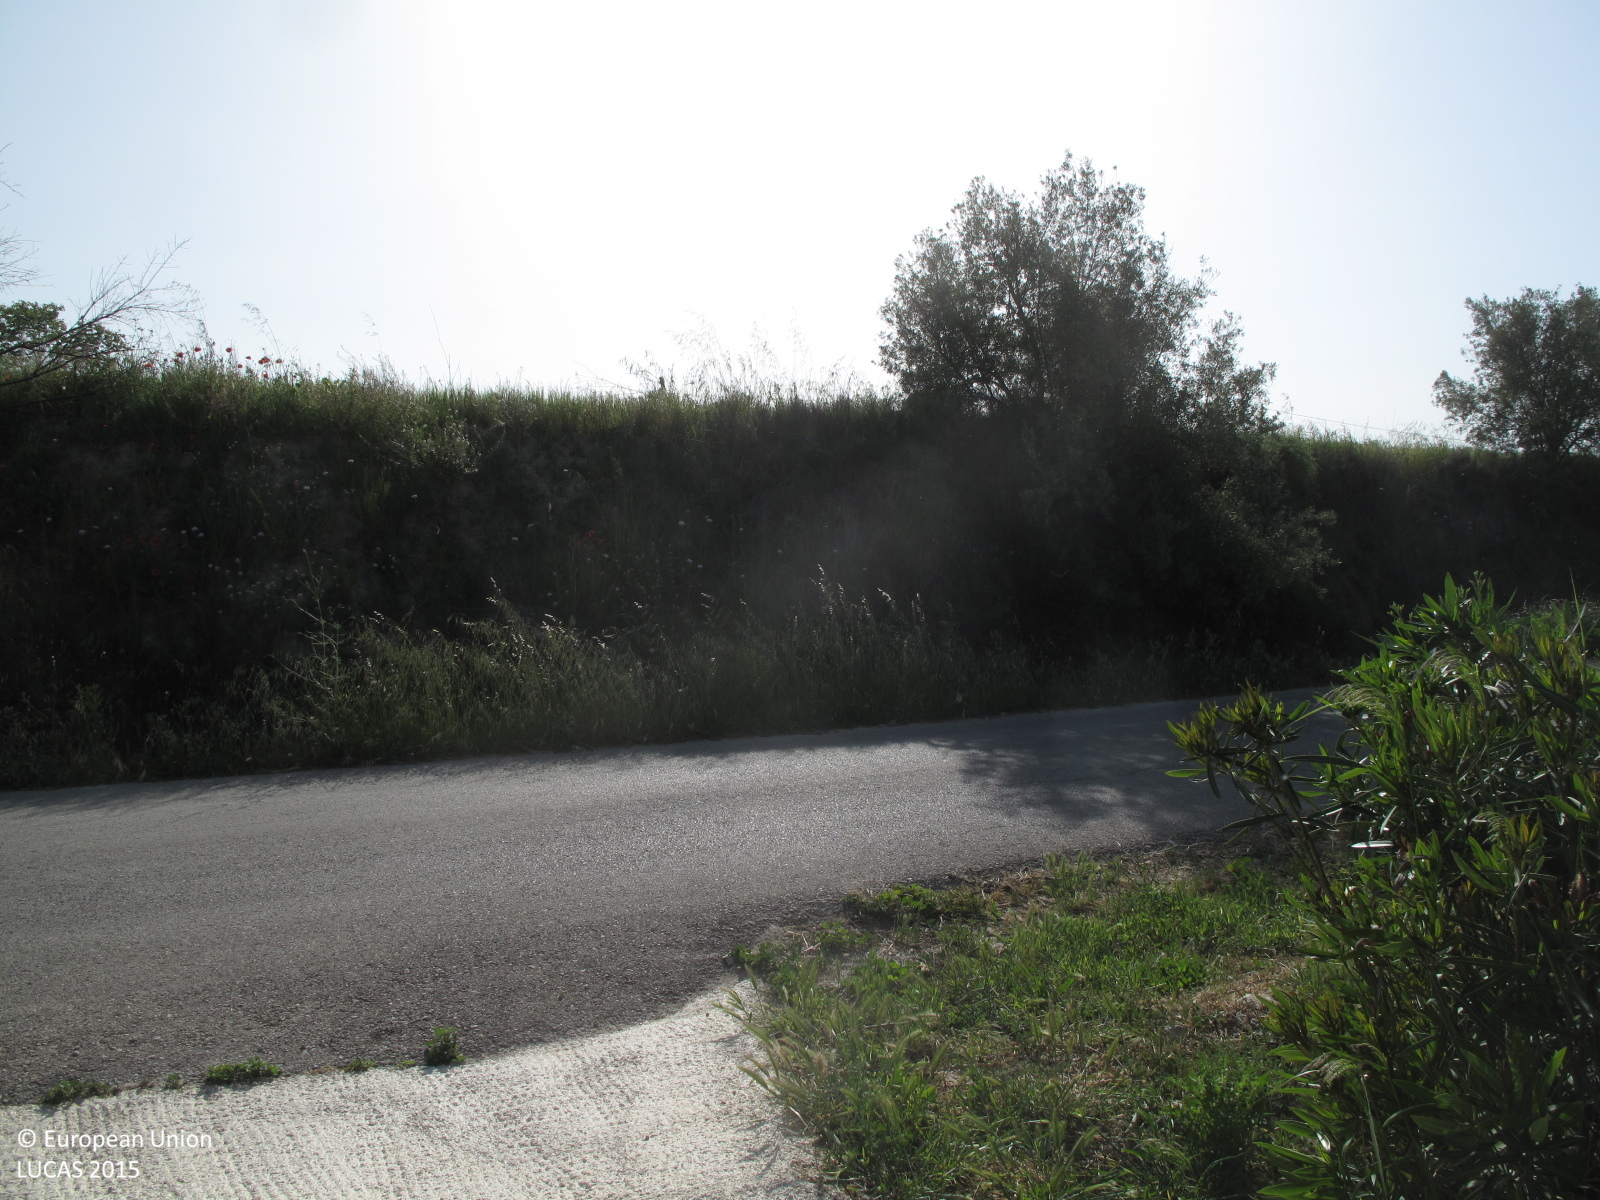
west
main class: Grassland
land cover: Grassland with sparse tree/shrub cover
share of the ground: > 75 %
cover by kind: herbaceous plants 95 %, broadleaved forest trees 5 %
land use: Residential
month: May
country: ES
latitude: 38.7875
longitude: -0.5243
